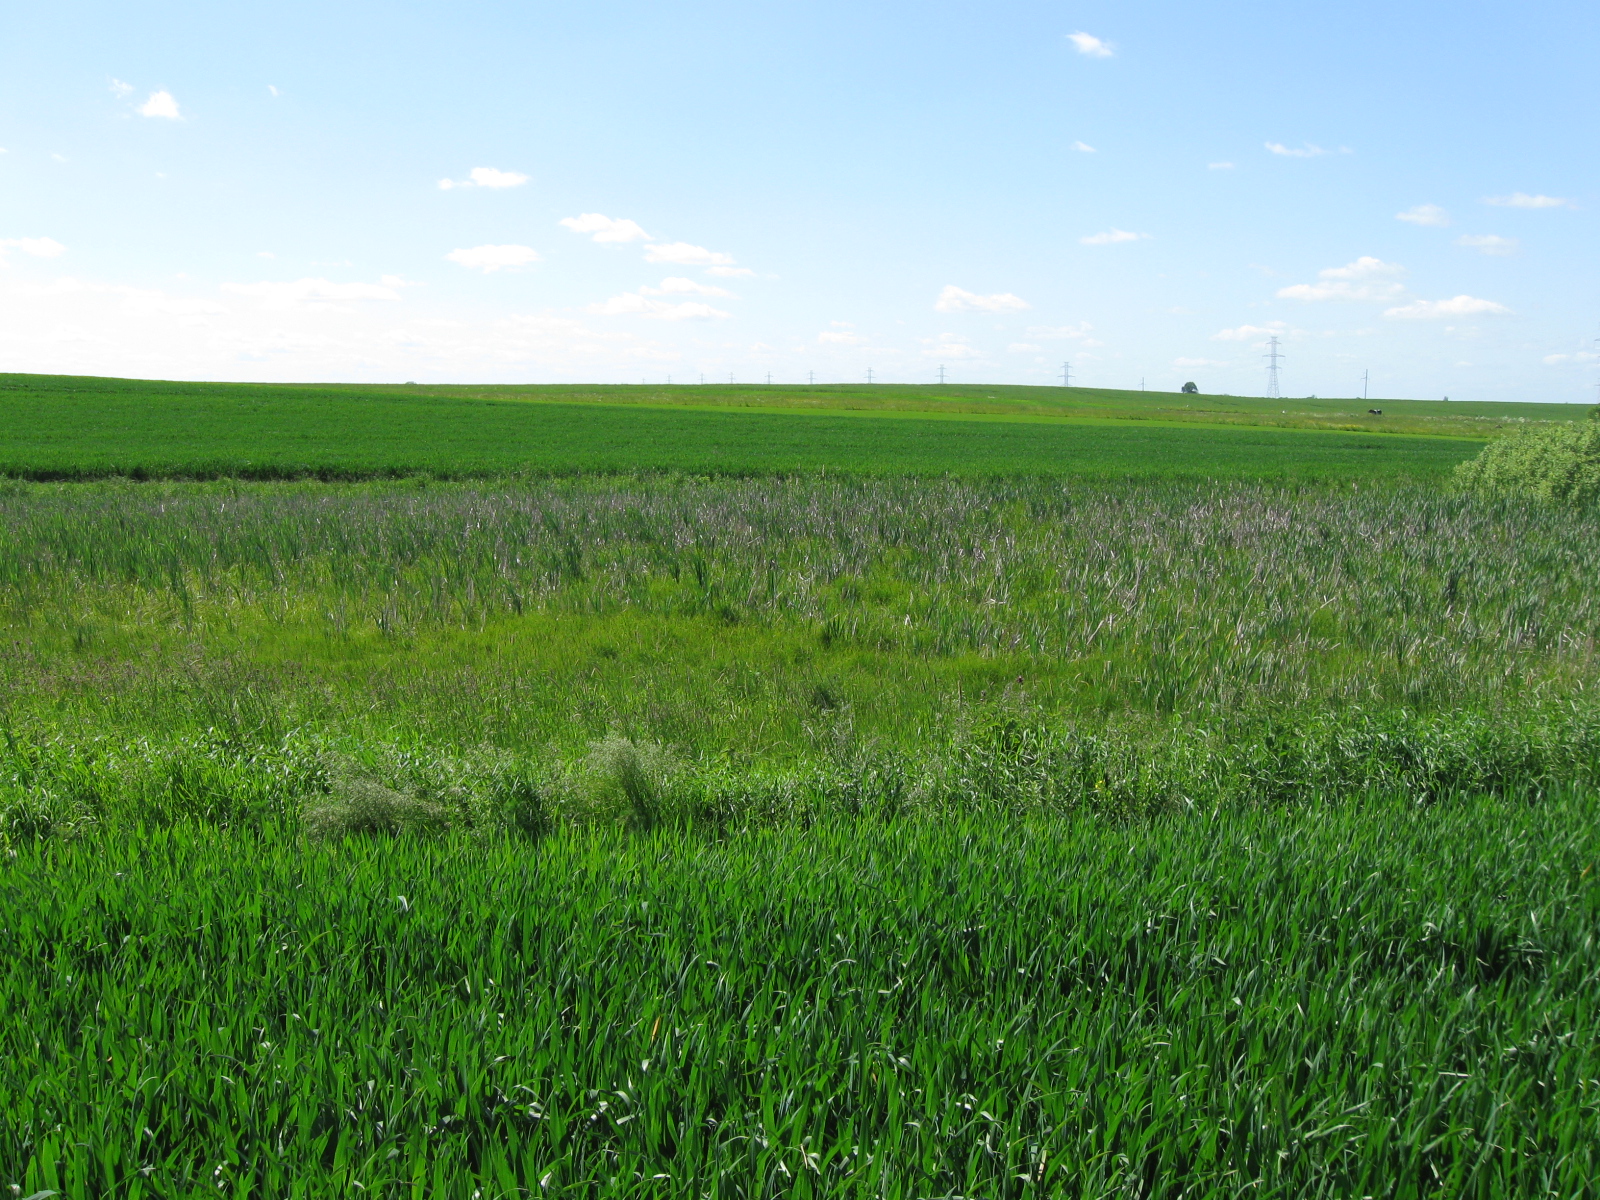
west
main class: Cropland
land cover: Common wheat
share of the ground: > 75 %
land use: Agriculture (excluding fallow land and kitchen gardens)
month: June
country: LT
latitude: 54.4123
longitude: 23.8174
